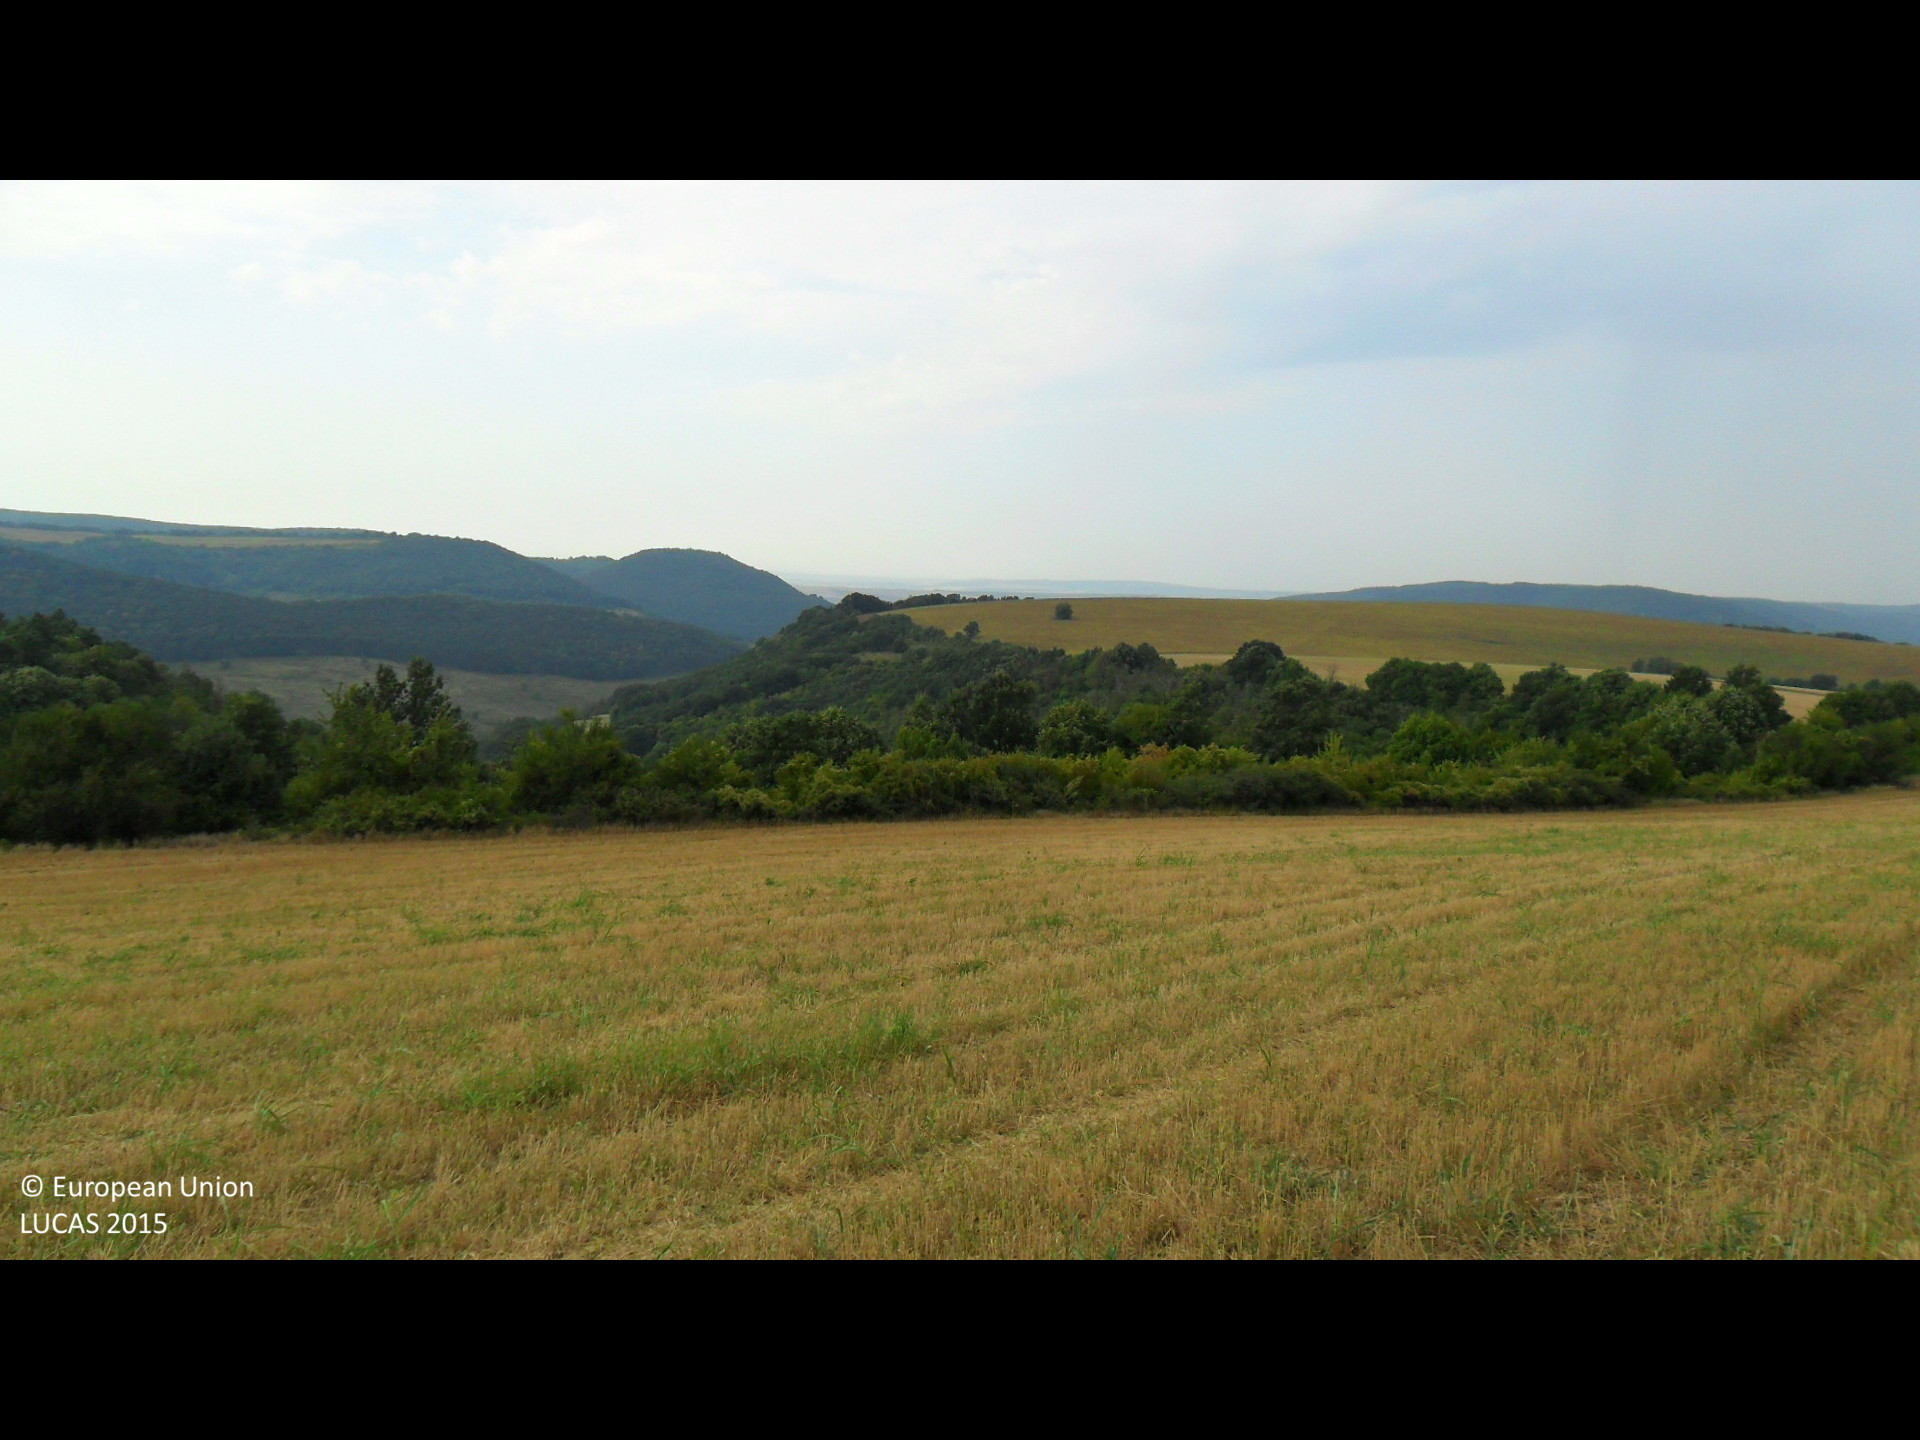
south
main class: Cropland
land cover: Barley
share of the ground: > 75 %
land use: Agriculture (excluding fallow land and kitchen gardens)
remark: Harvested field
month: August
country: BG
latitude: 43.4708
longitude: 26.2042
